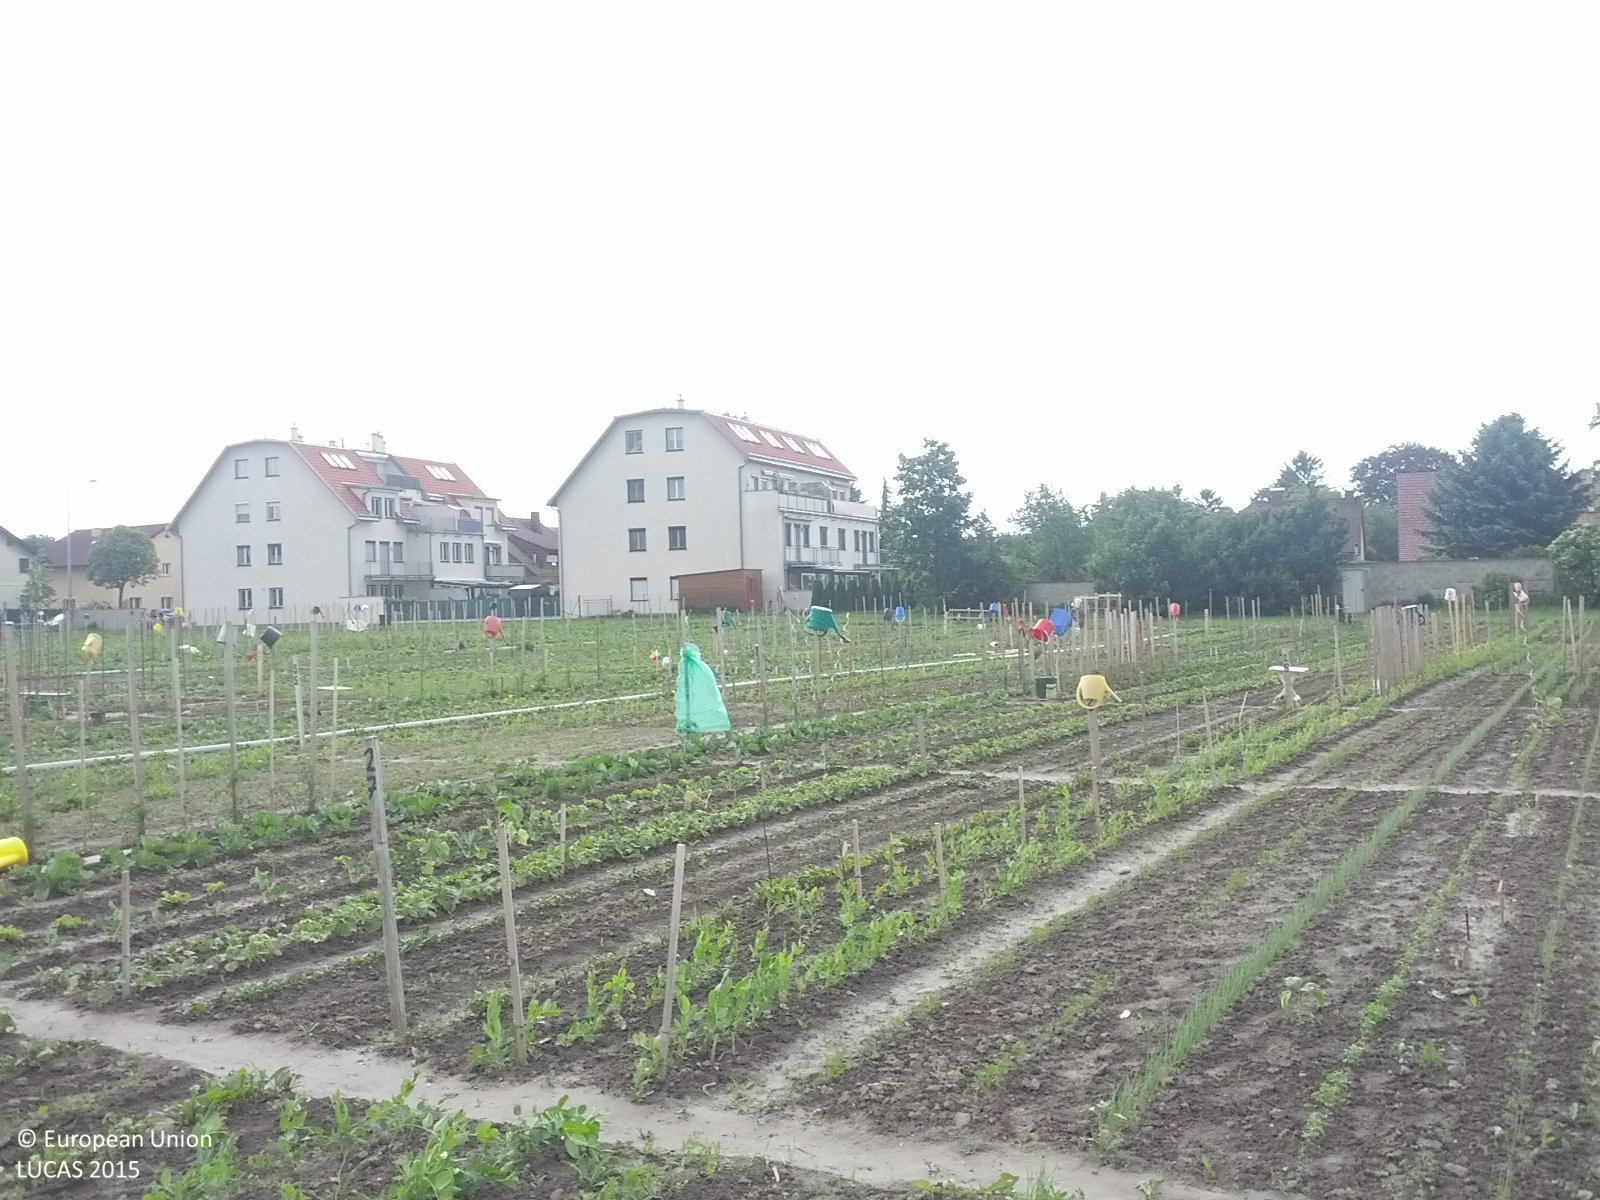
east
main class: Cropland
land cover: Other fresh vegetables
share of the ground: 25 - 50 %
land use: Kitchen garden
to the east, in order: Other fresh vegetables; Grassland without tree/shrub cover; Artificial constructions in urban areas
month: May
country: AT
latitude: 48.2103
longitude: 16.5324
